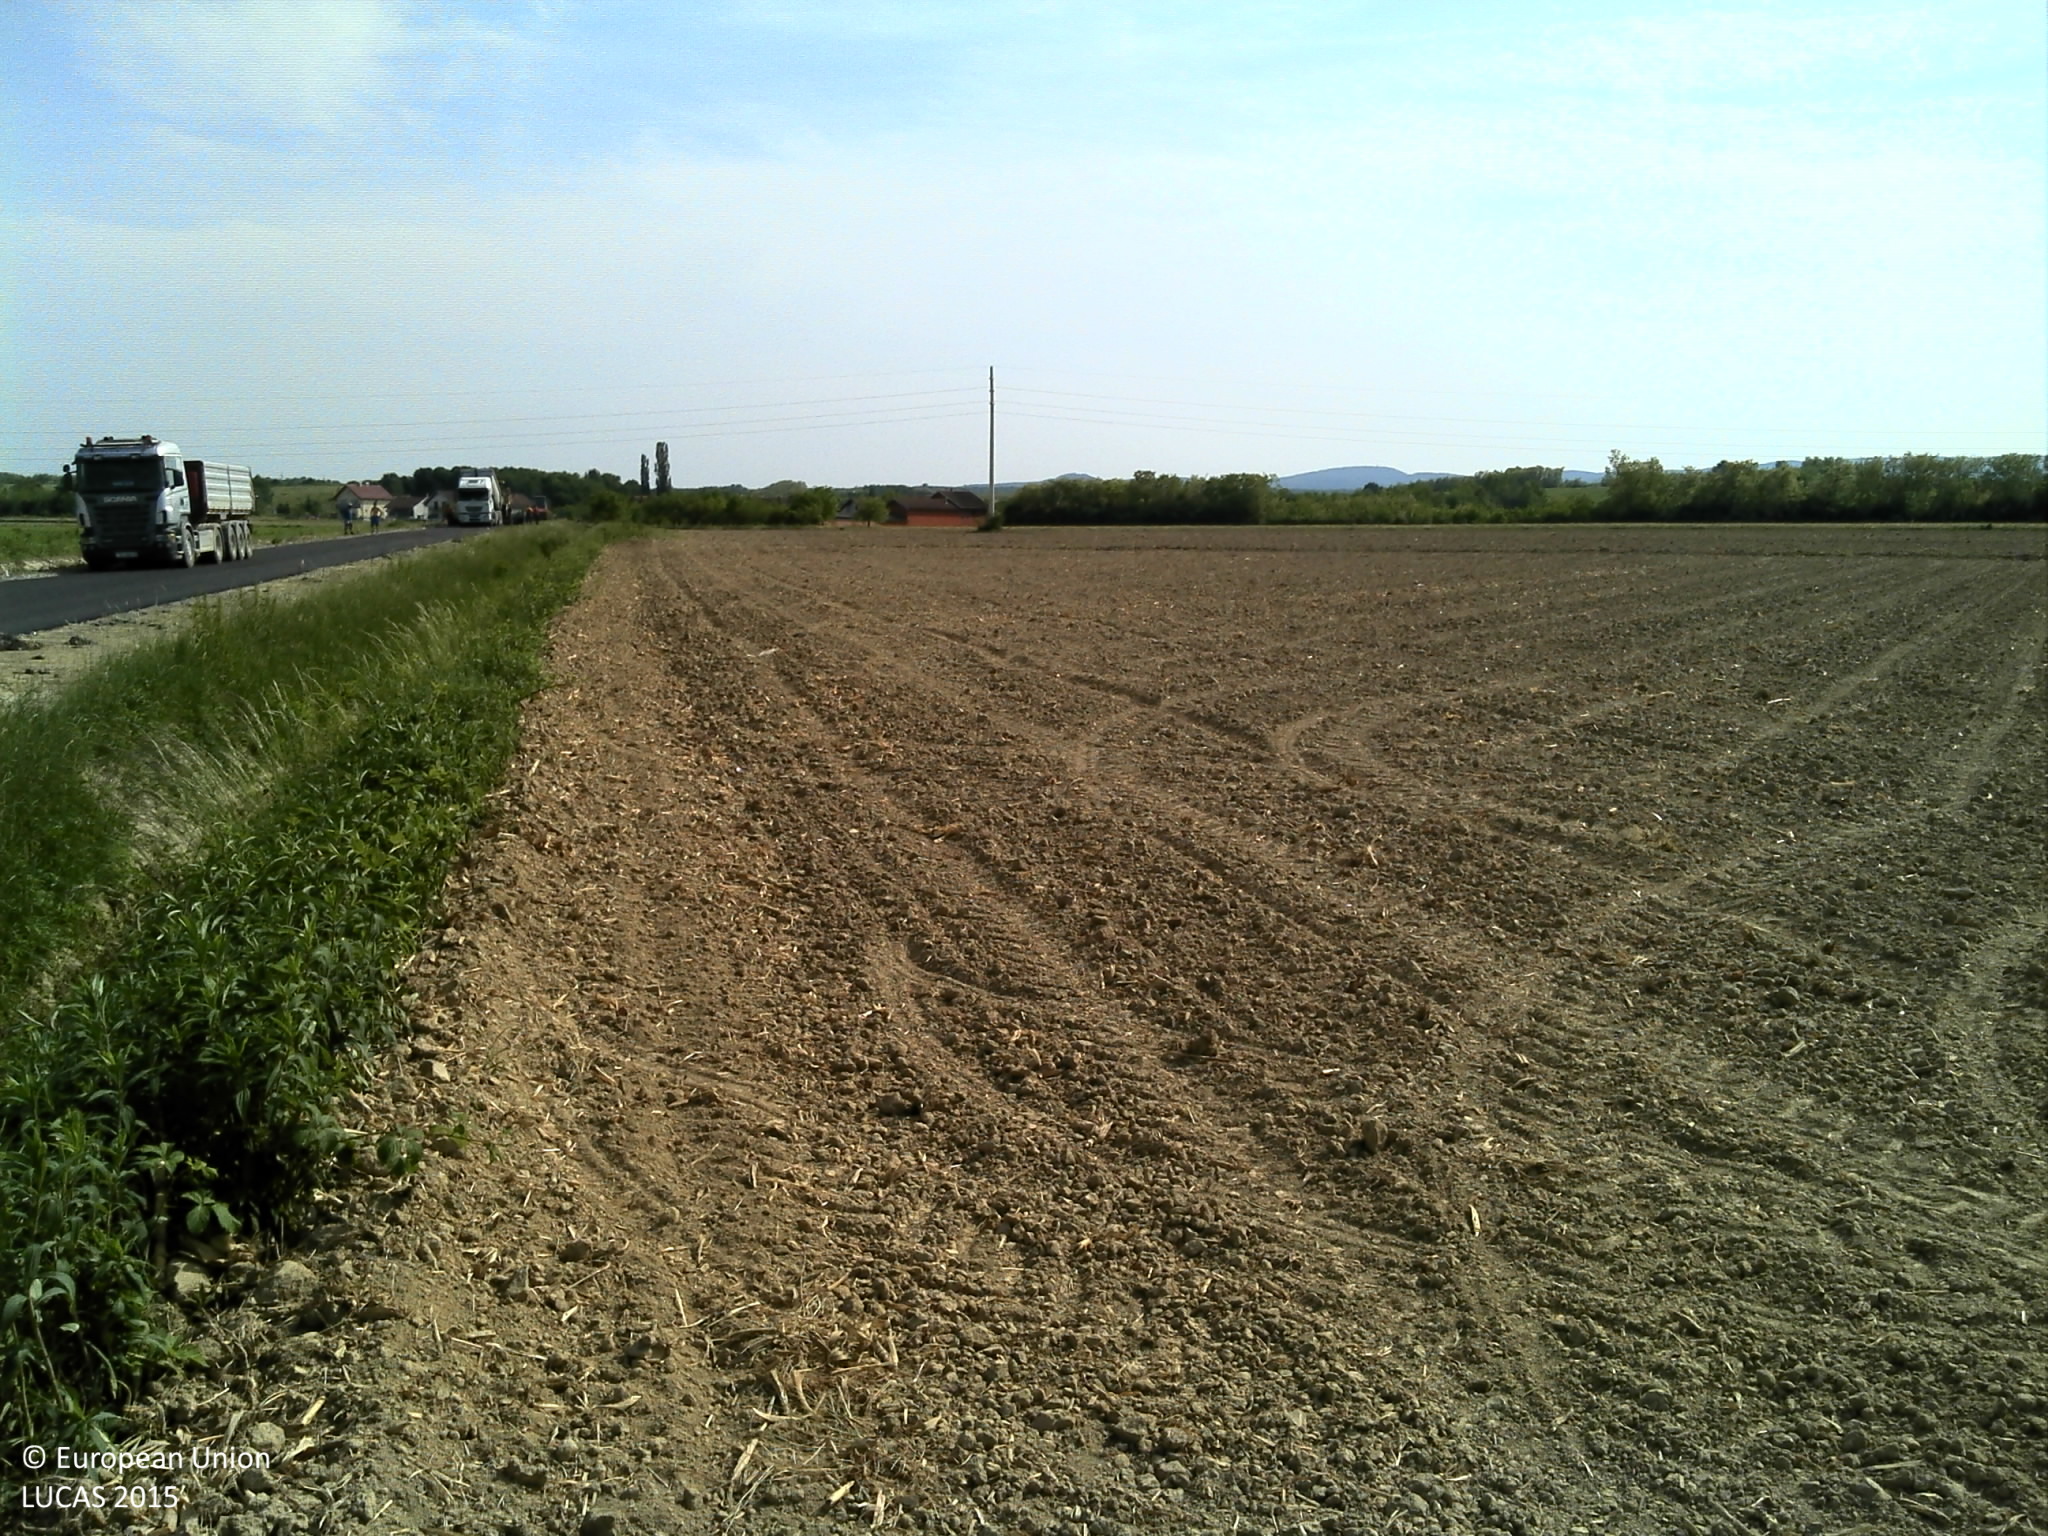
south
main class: Cropland
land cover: Maize
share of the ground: < 10 %
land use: Agriculture (excluding fallow land and kitchen gardens)
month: May
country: HR
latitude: 45.5220
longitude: 18.0570
